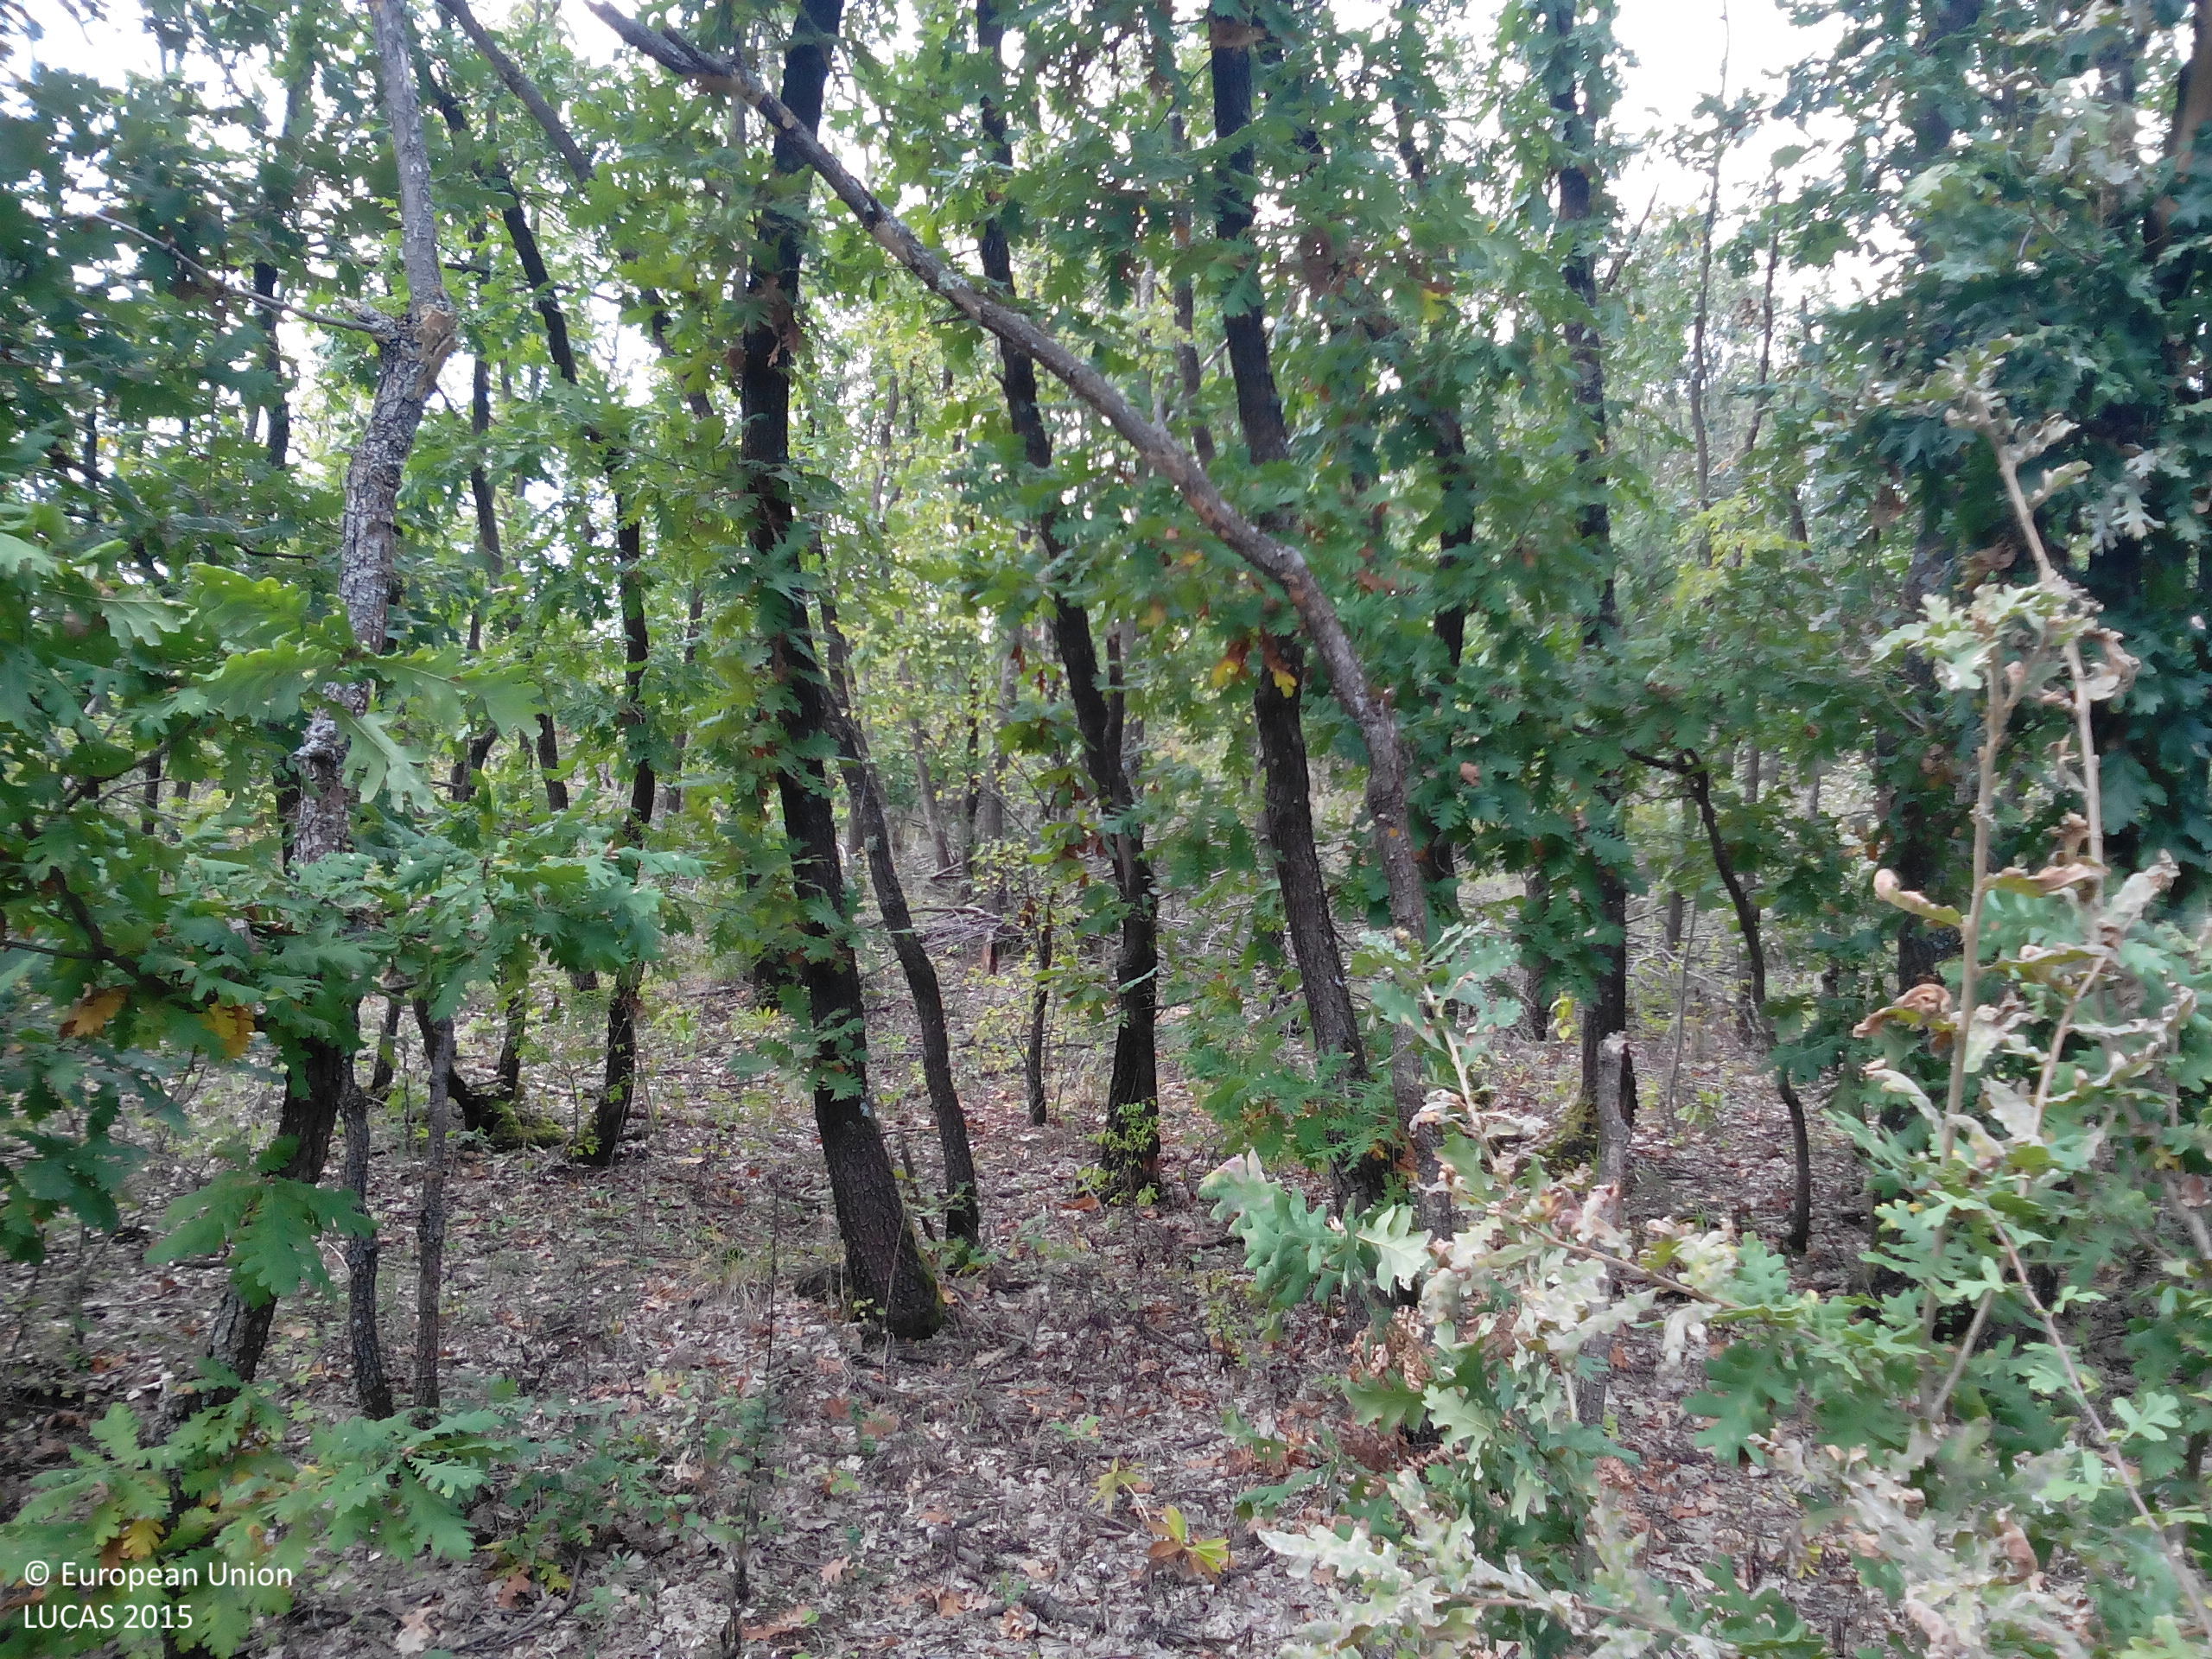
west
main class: Woodland
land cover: Broadleaved woodland
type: acidophilous oak and oak-birch forest
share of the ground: > 75 %
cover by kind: broadleaved forest trees 75 %, shrubs 15 %, herbaceous plants 10 %
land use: Forestry
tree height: > 5 m
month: October
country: BG
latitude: 43.2103
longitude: 24.0208
